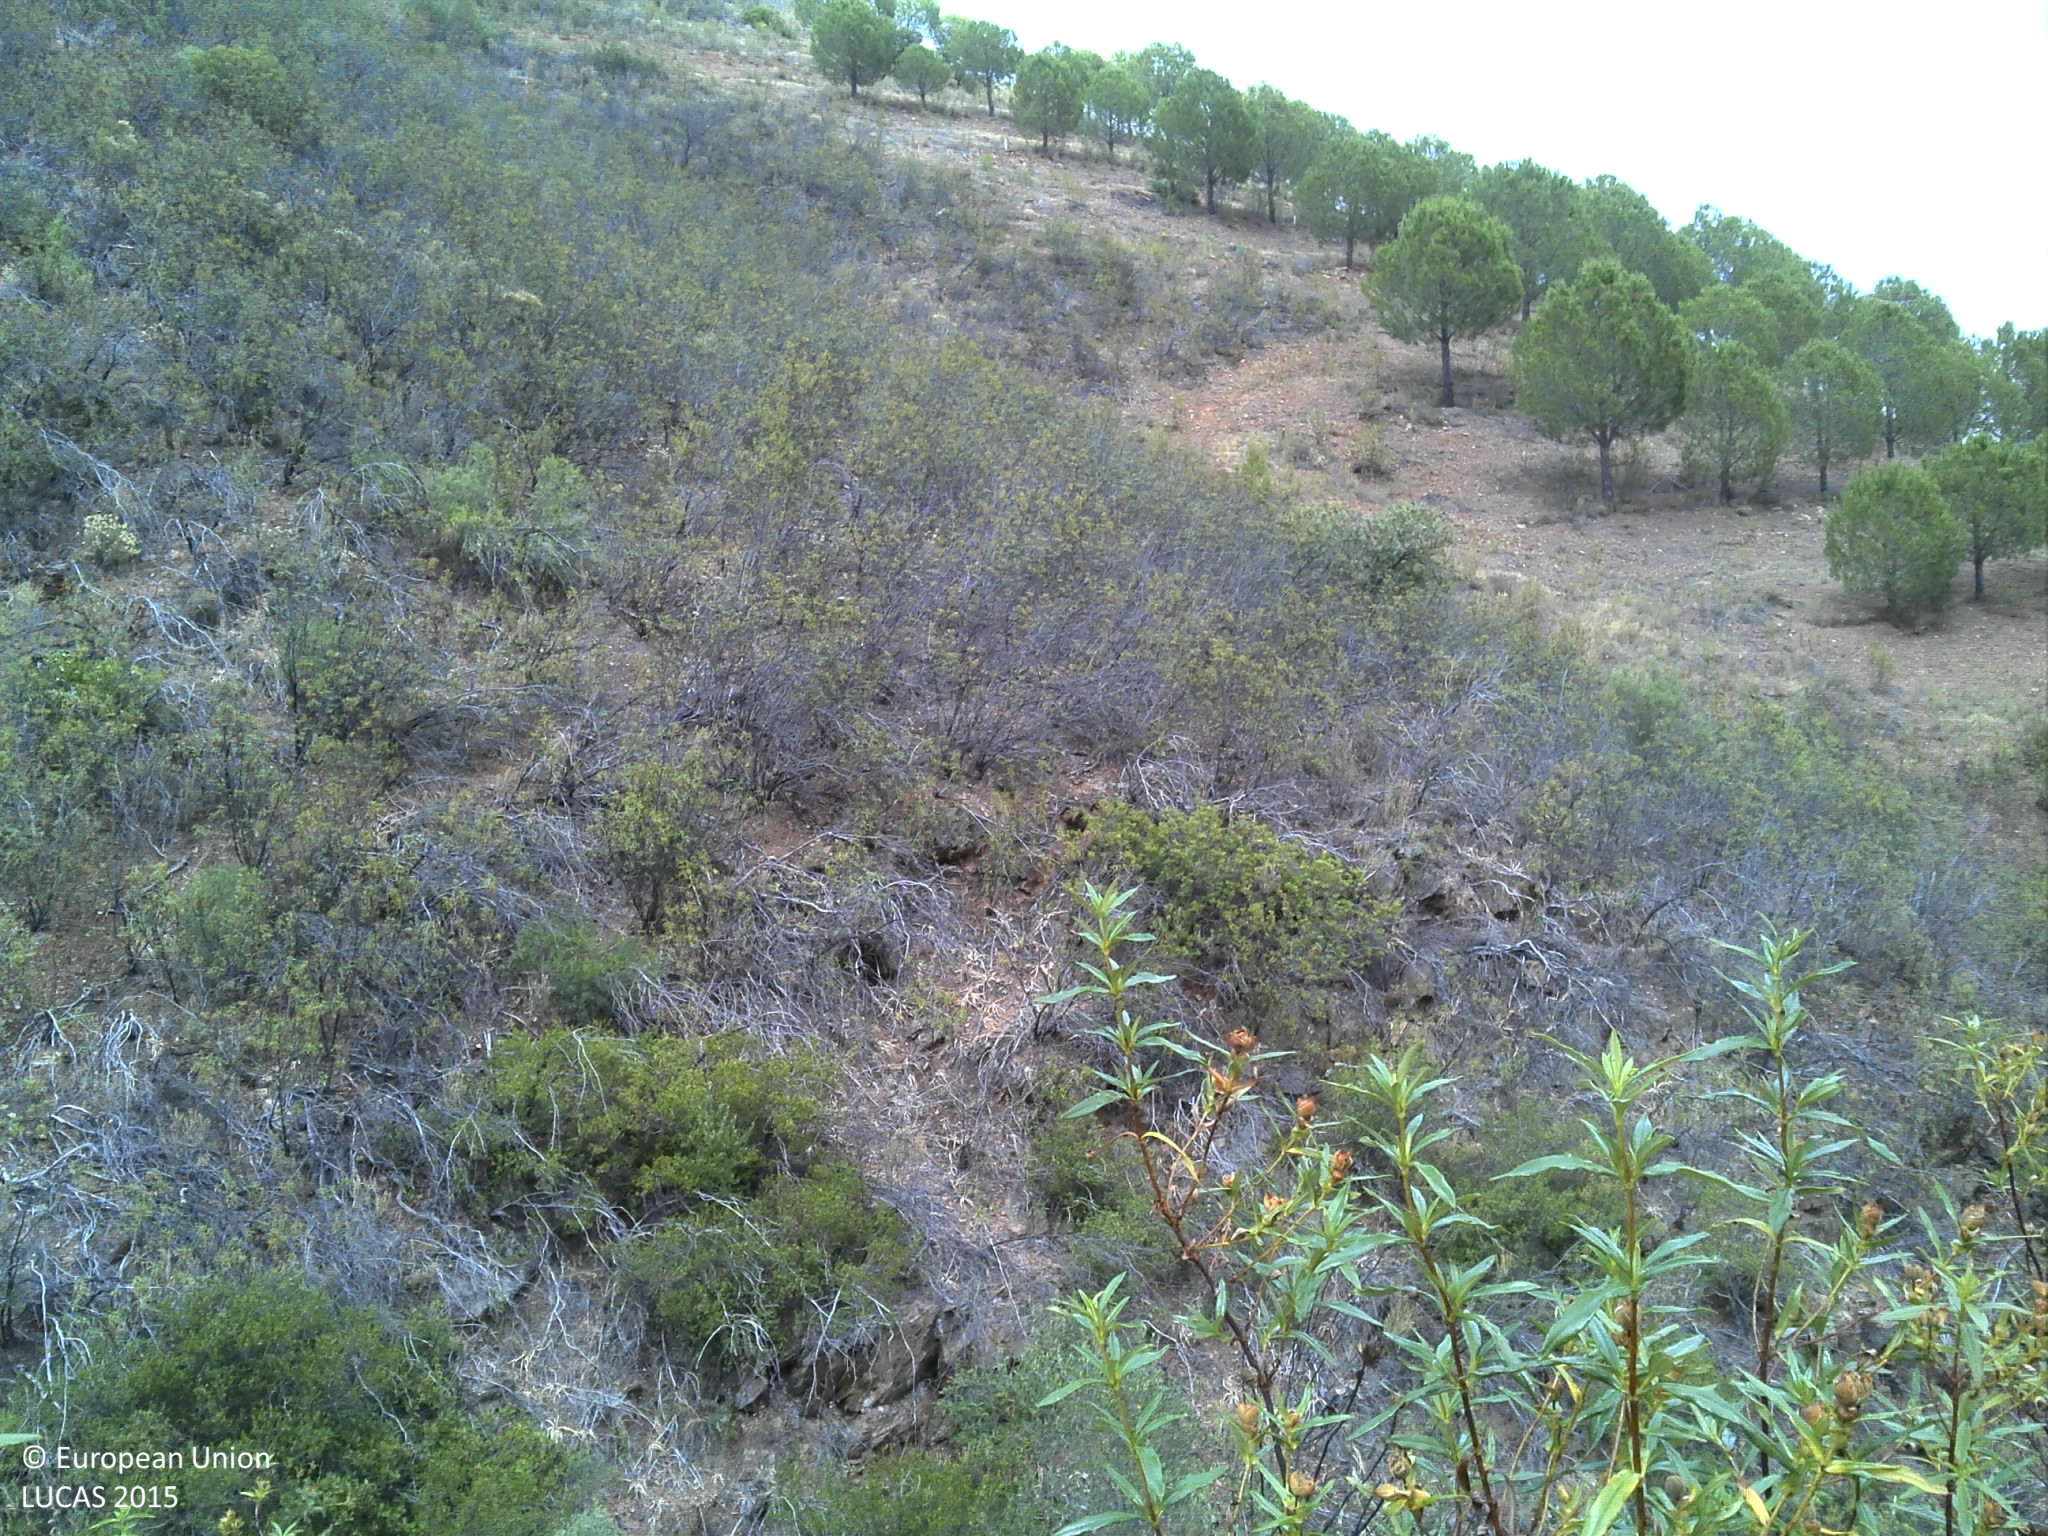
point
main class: Shrubland
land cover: Shrubland without tree cover
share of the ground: > 75 %
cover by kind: shrubs 80 %, herbaceous plants 10 %, unconsolidated bare surface 10 %
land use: Abandoned areas
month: June
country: PT
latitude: 37.3194
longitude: -7.7616
